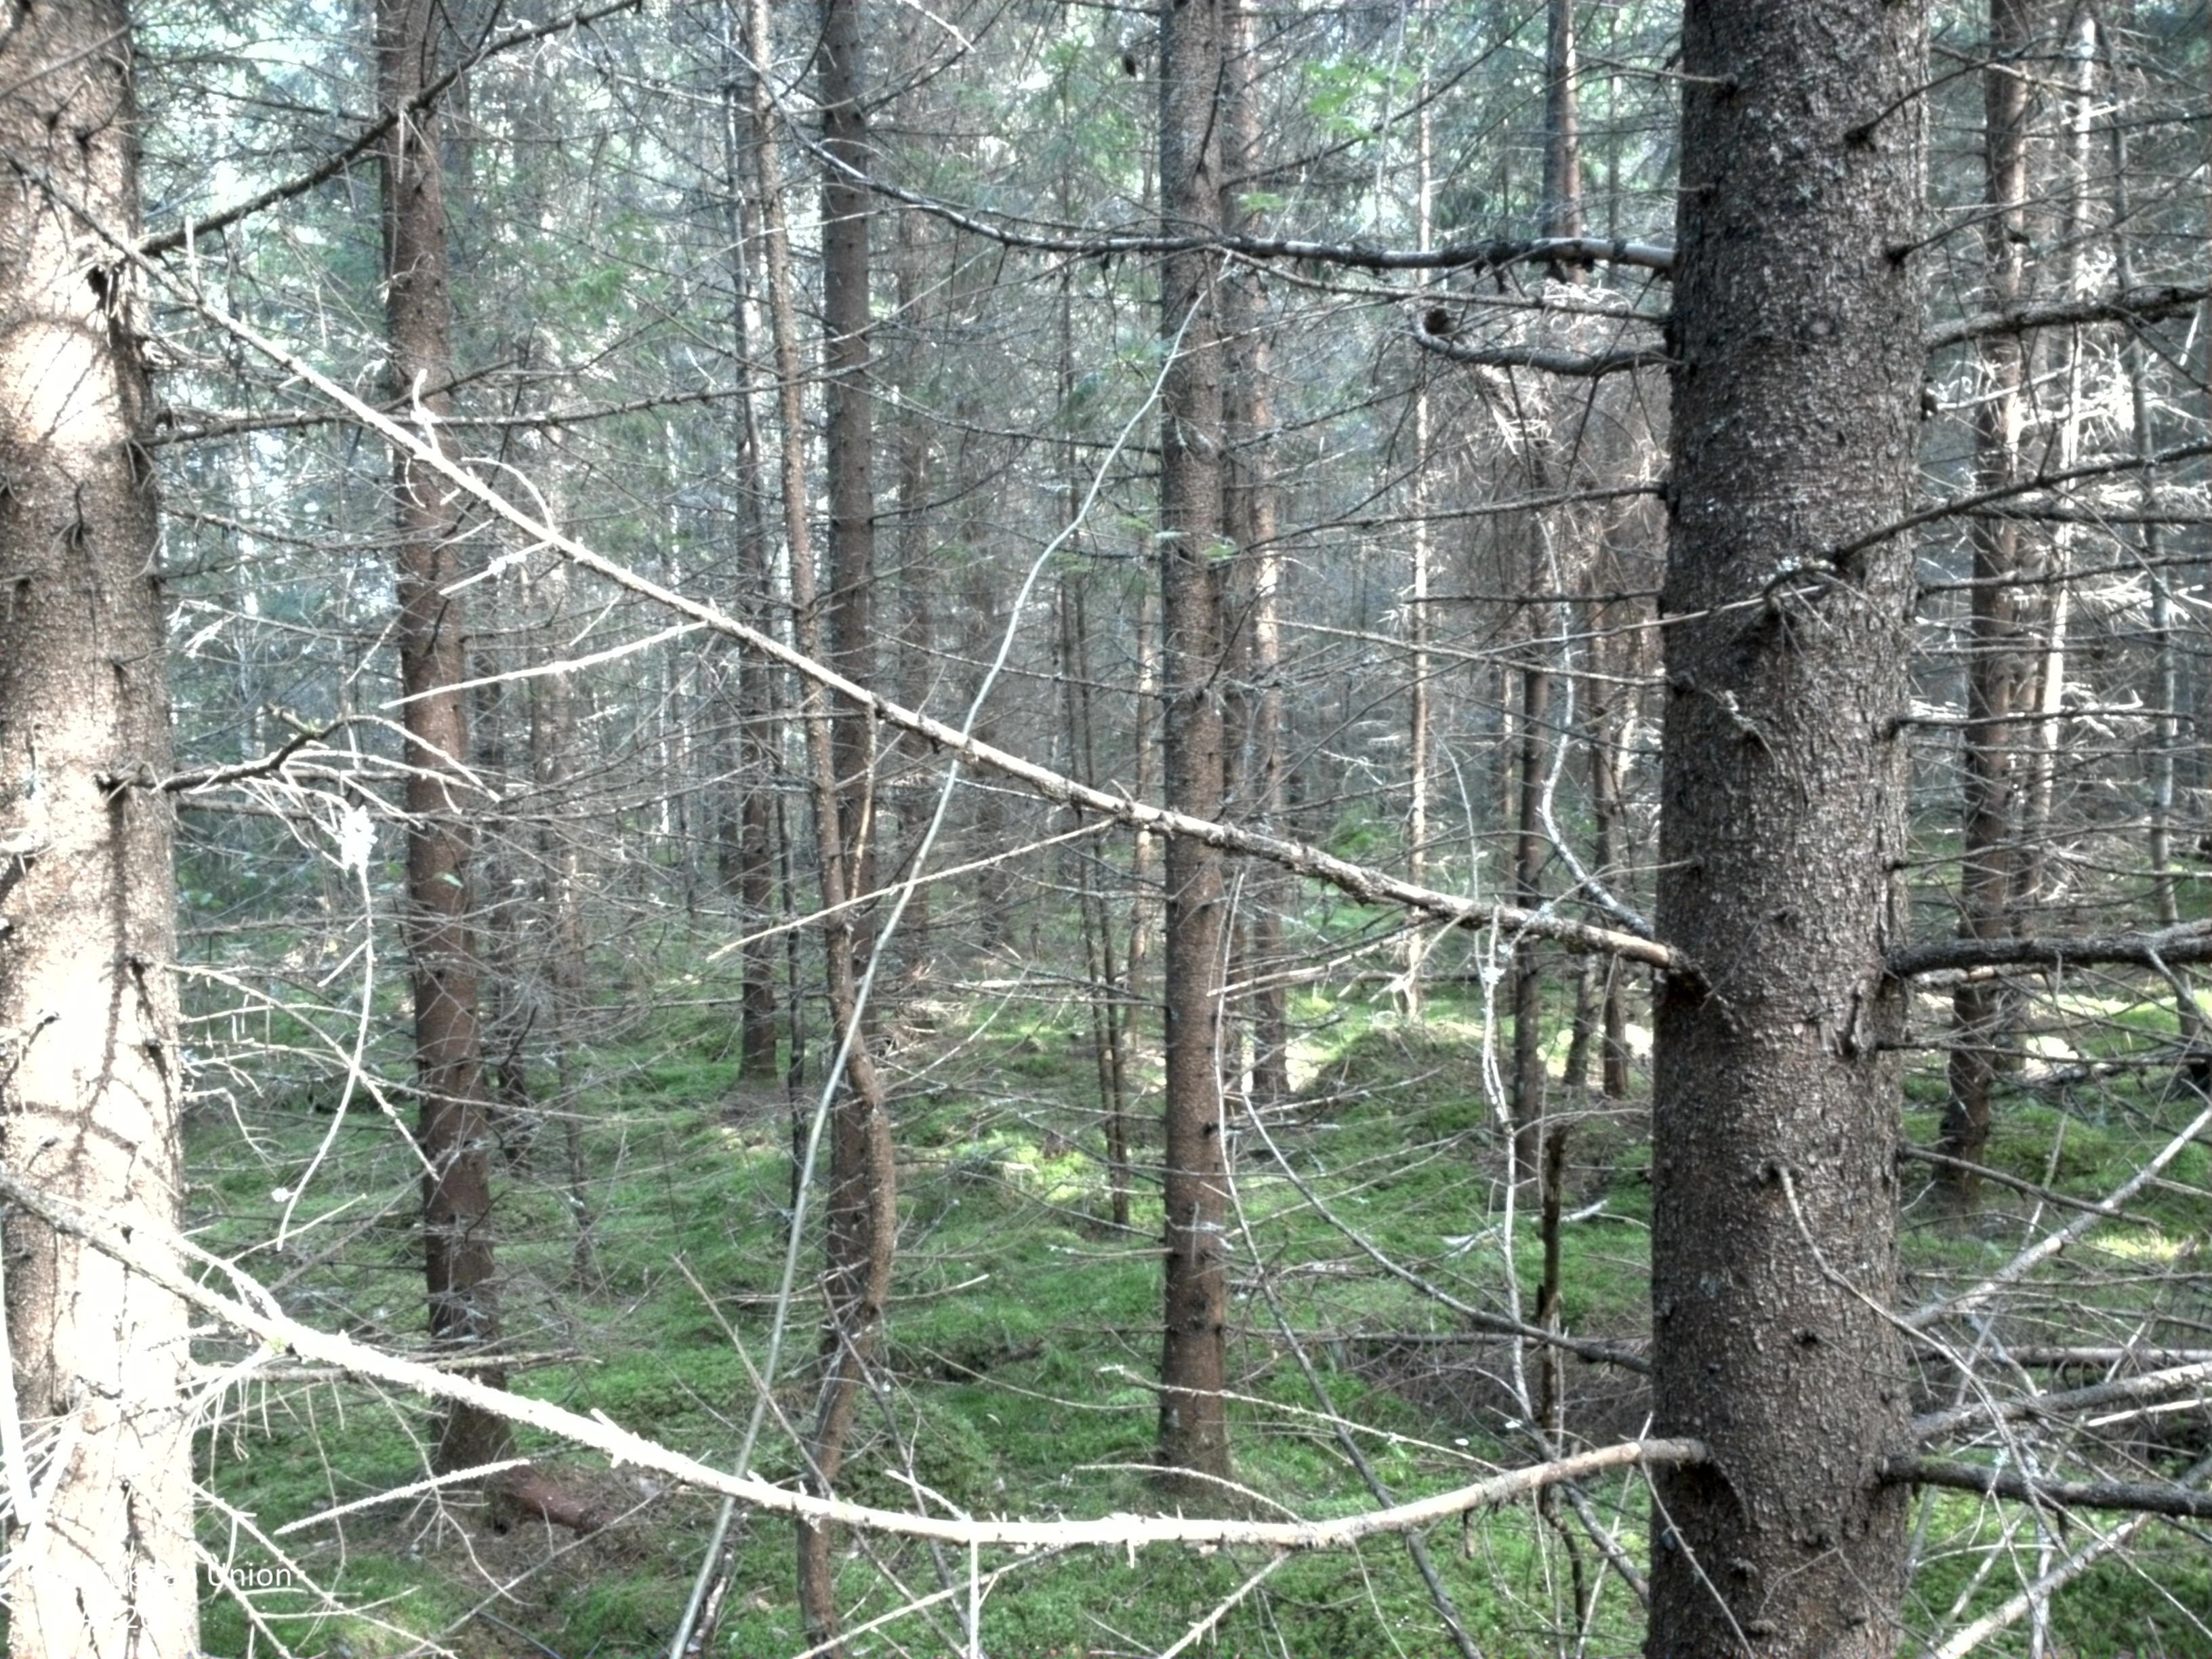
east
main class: Woodland
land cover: Spruce dominated coniferous woodland
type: boreal forest
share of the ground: > 75 %
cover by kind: coniferous forest trees 95 %, lichens and mosses 5 %
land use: Forestry
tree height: > 5 m
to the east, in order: Spruce dominated coniferous woodland; Broadleaved woodland; Electric lines; Other coniferous woodland; Spruce dominated mixed woodland; Broadleaved woodland; Ditches and canals; Oats; Ditches and canals; Common wheat
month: August
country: SE
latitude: 59.9606
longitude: 16.4557
